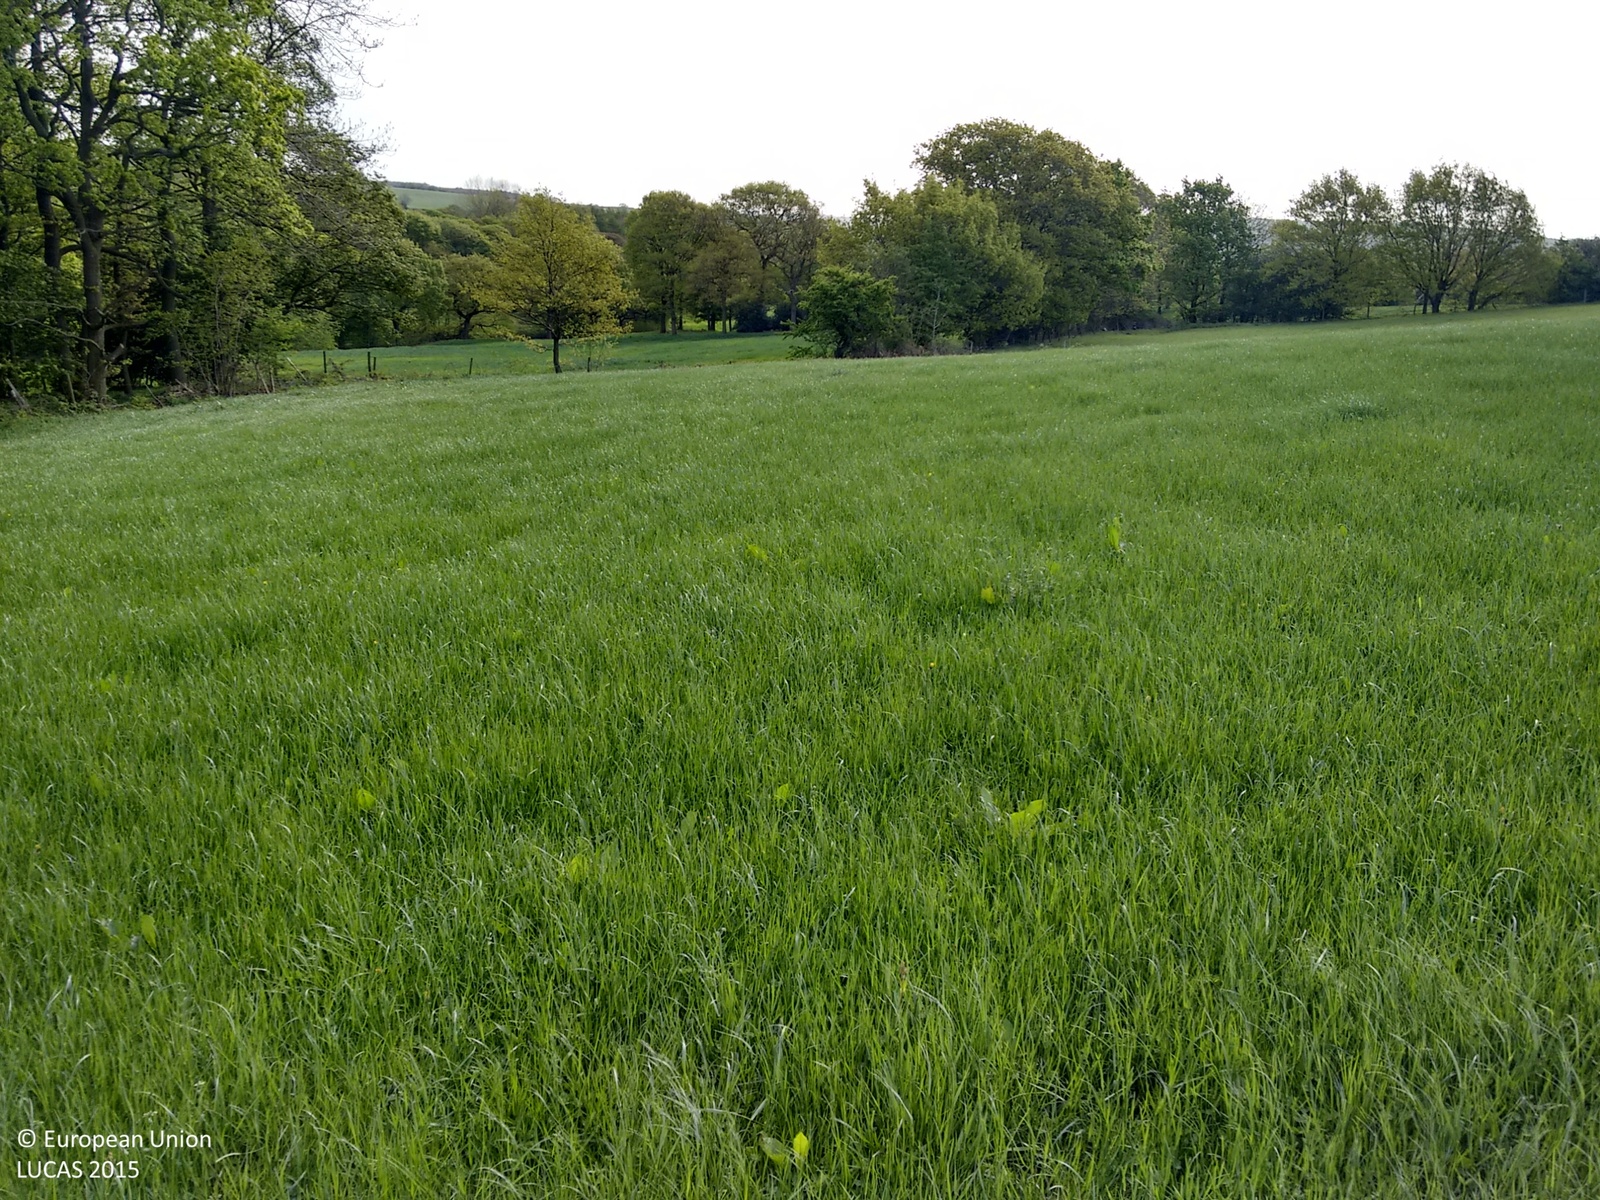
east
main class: Grassland
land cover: Grassland without tree/shrub cover
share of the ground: > 75 %
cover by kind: herbaceous plants 100 %
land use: Agriculture (excluding fallow land and kitchen gardens)
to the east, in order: Grassland without tree/shrub cover; Fences; Ditches and canals; Lines of trees; Common wheat; Broadleaved woodland; Common wheat
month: May
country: GB
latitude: 53.5985
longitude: -1.6724
